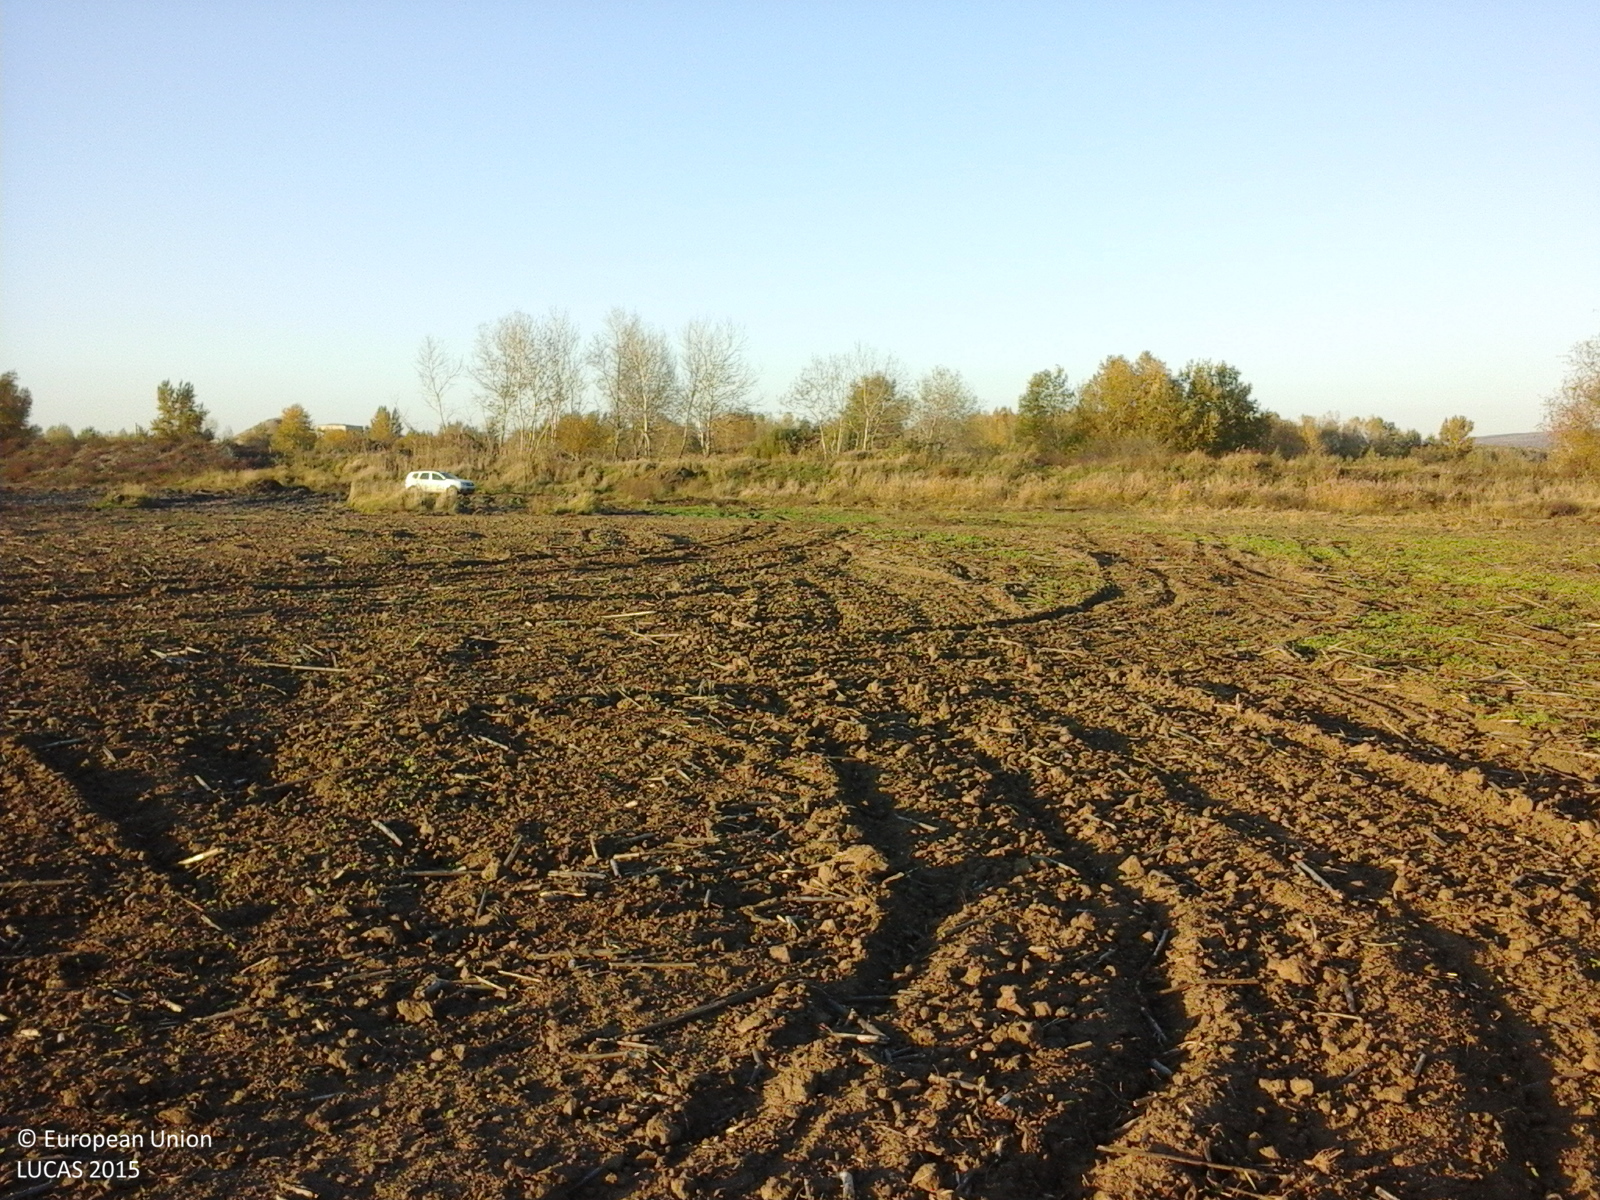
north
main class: Cropland
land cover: Sunflower
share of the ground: < 10 %
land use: Agriculture (excluding fallow land and kitchen gardens)
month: October
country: RO
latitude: 46.1014
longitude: 27.2134
